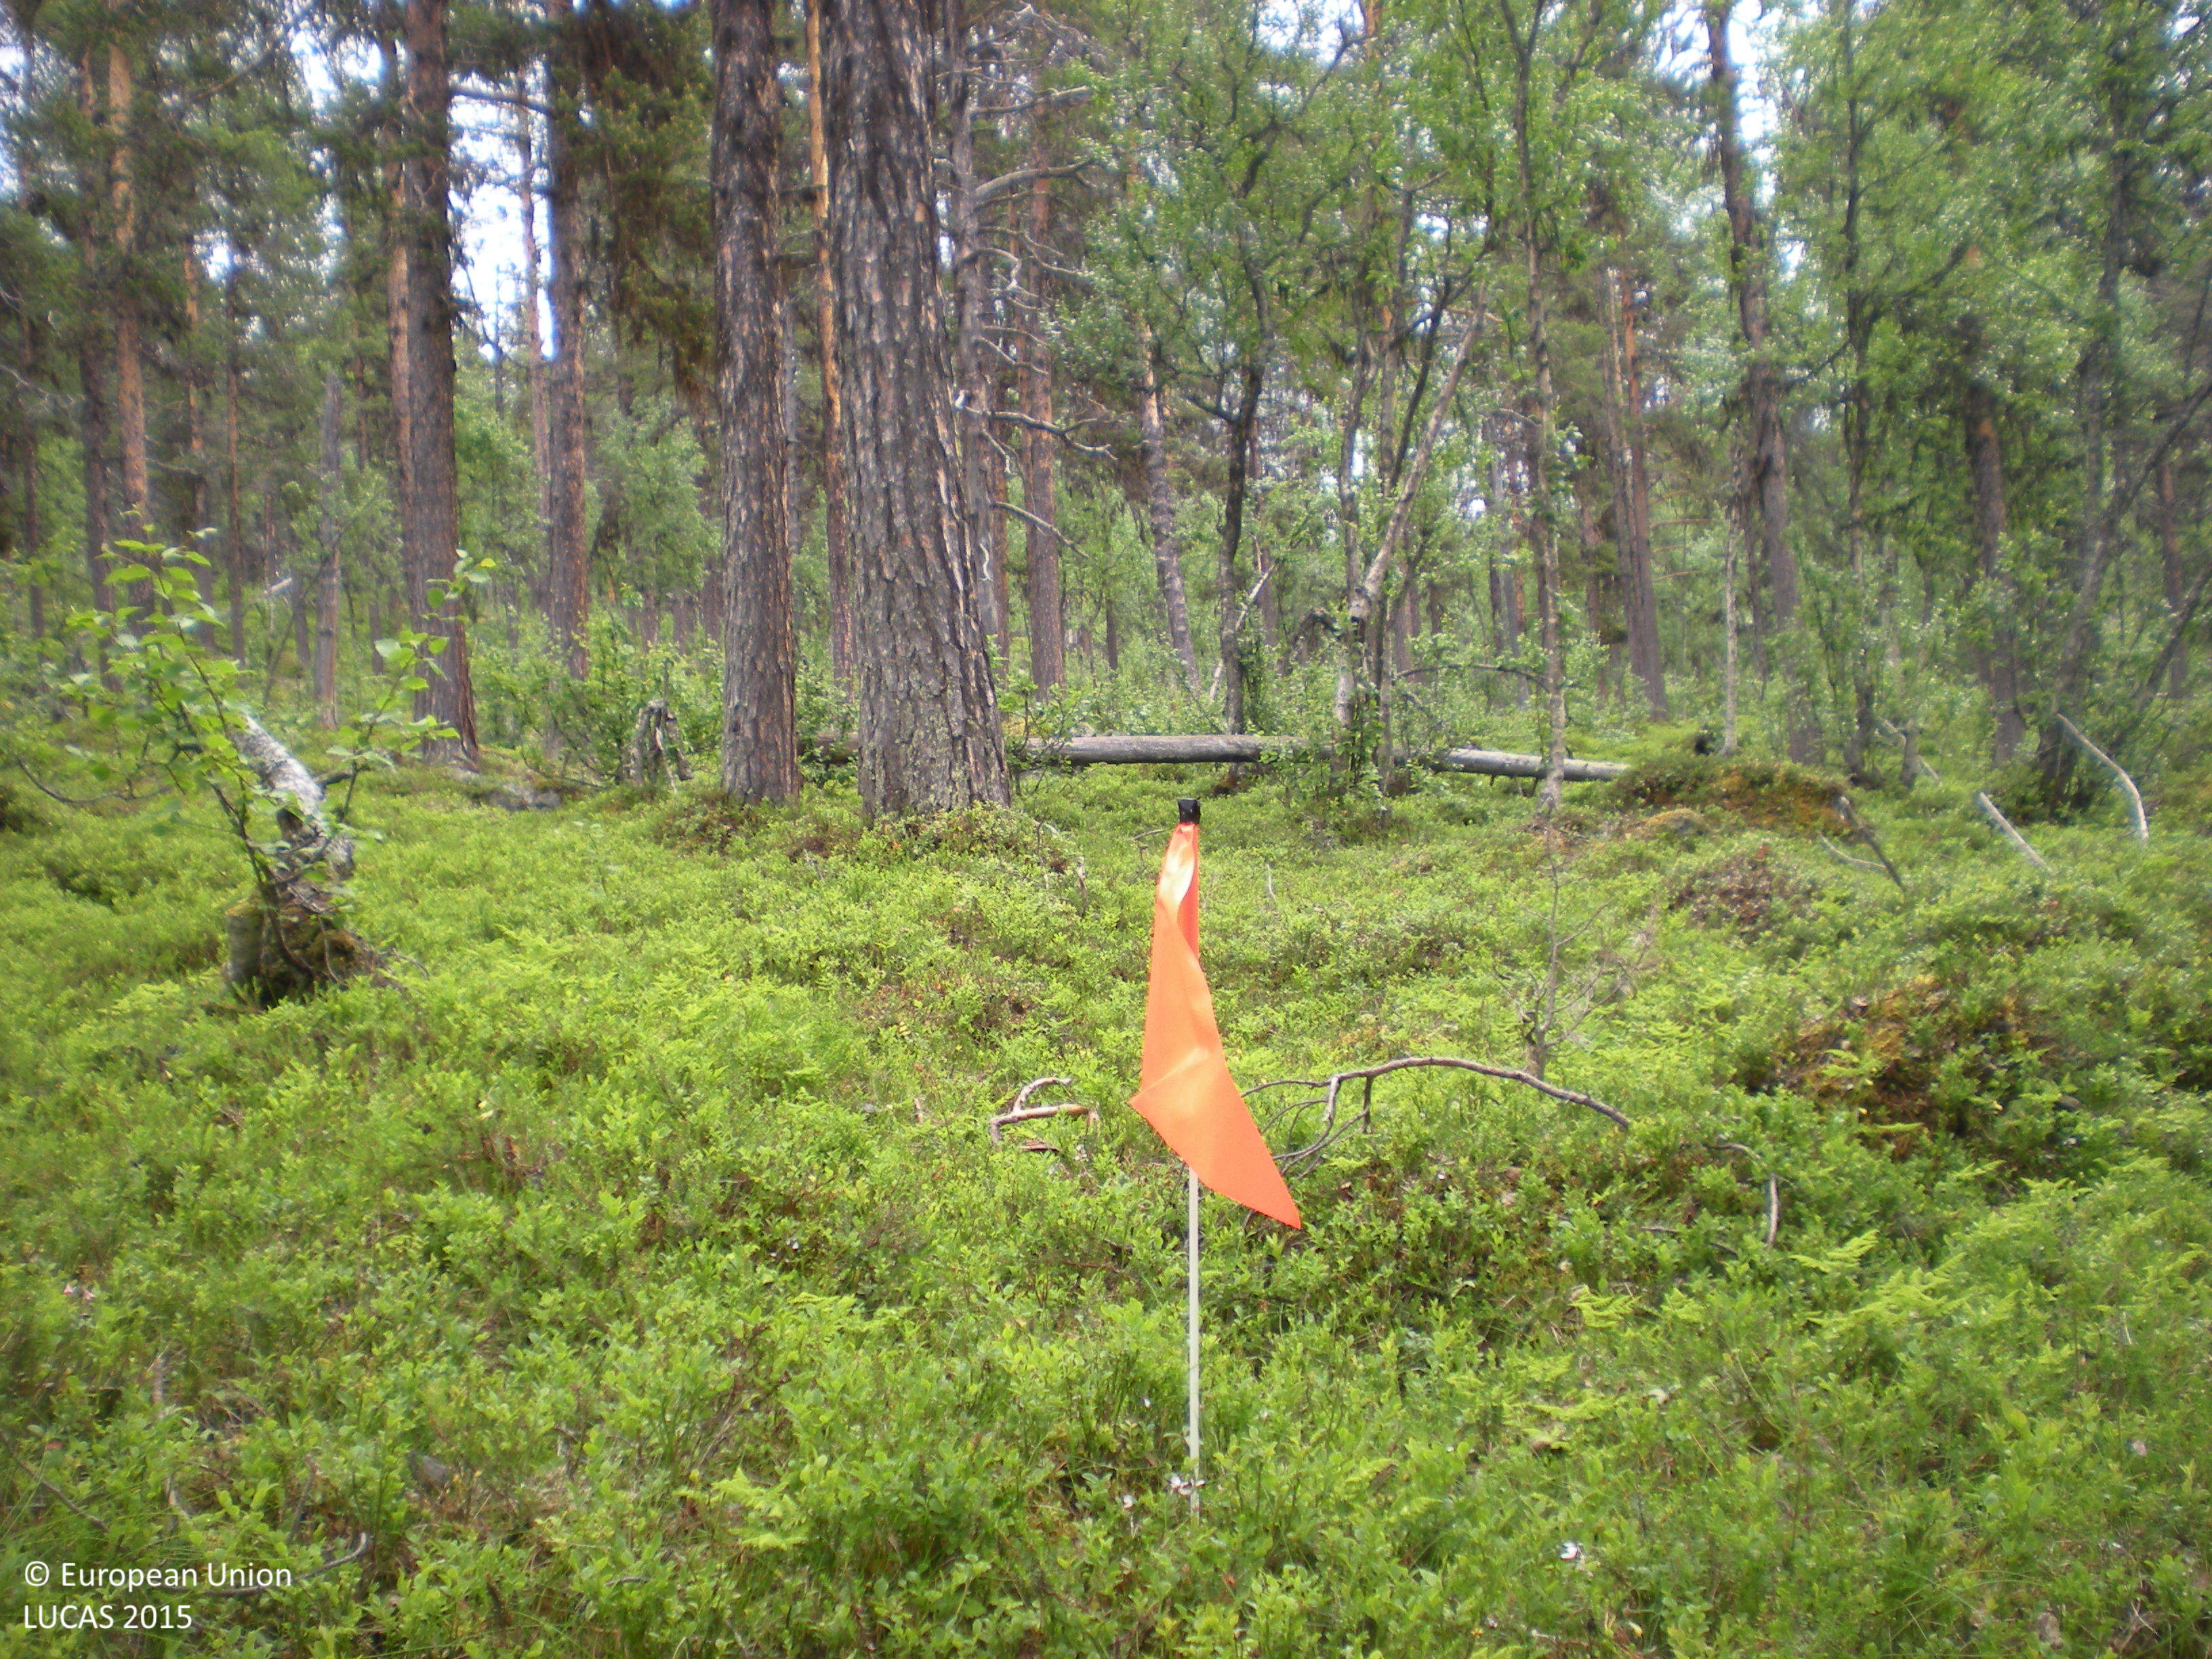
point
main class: Woodland
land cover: Pine dominated mixed woodland
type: boreal forest
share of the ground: 50 - 75 %
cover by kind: coniferous forest trees 55 %, broadleaved forest trees 20 %, shrubs 20 %, lichens and mosses 5 %
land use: Forestry
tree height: > 5 m
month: July
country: SE
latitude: 66.2187
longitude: 17.0887
